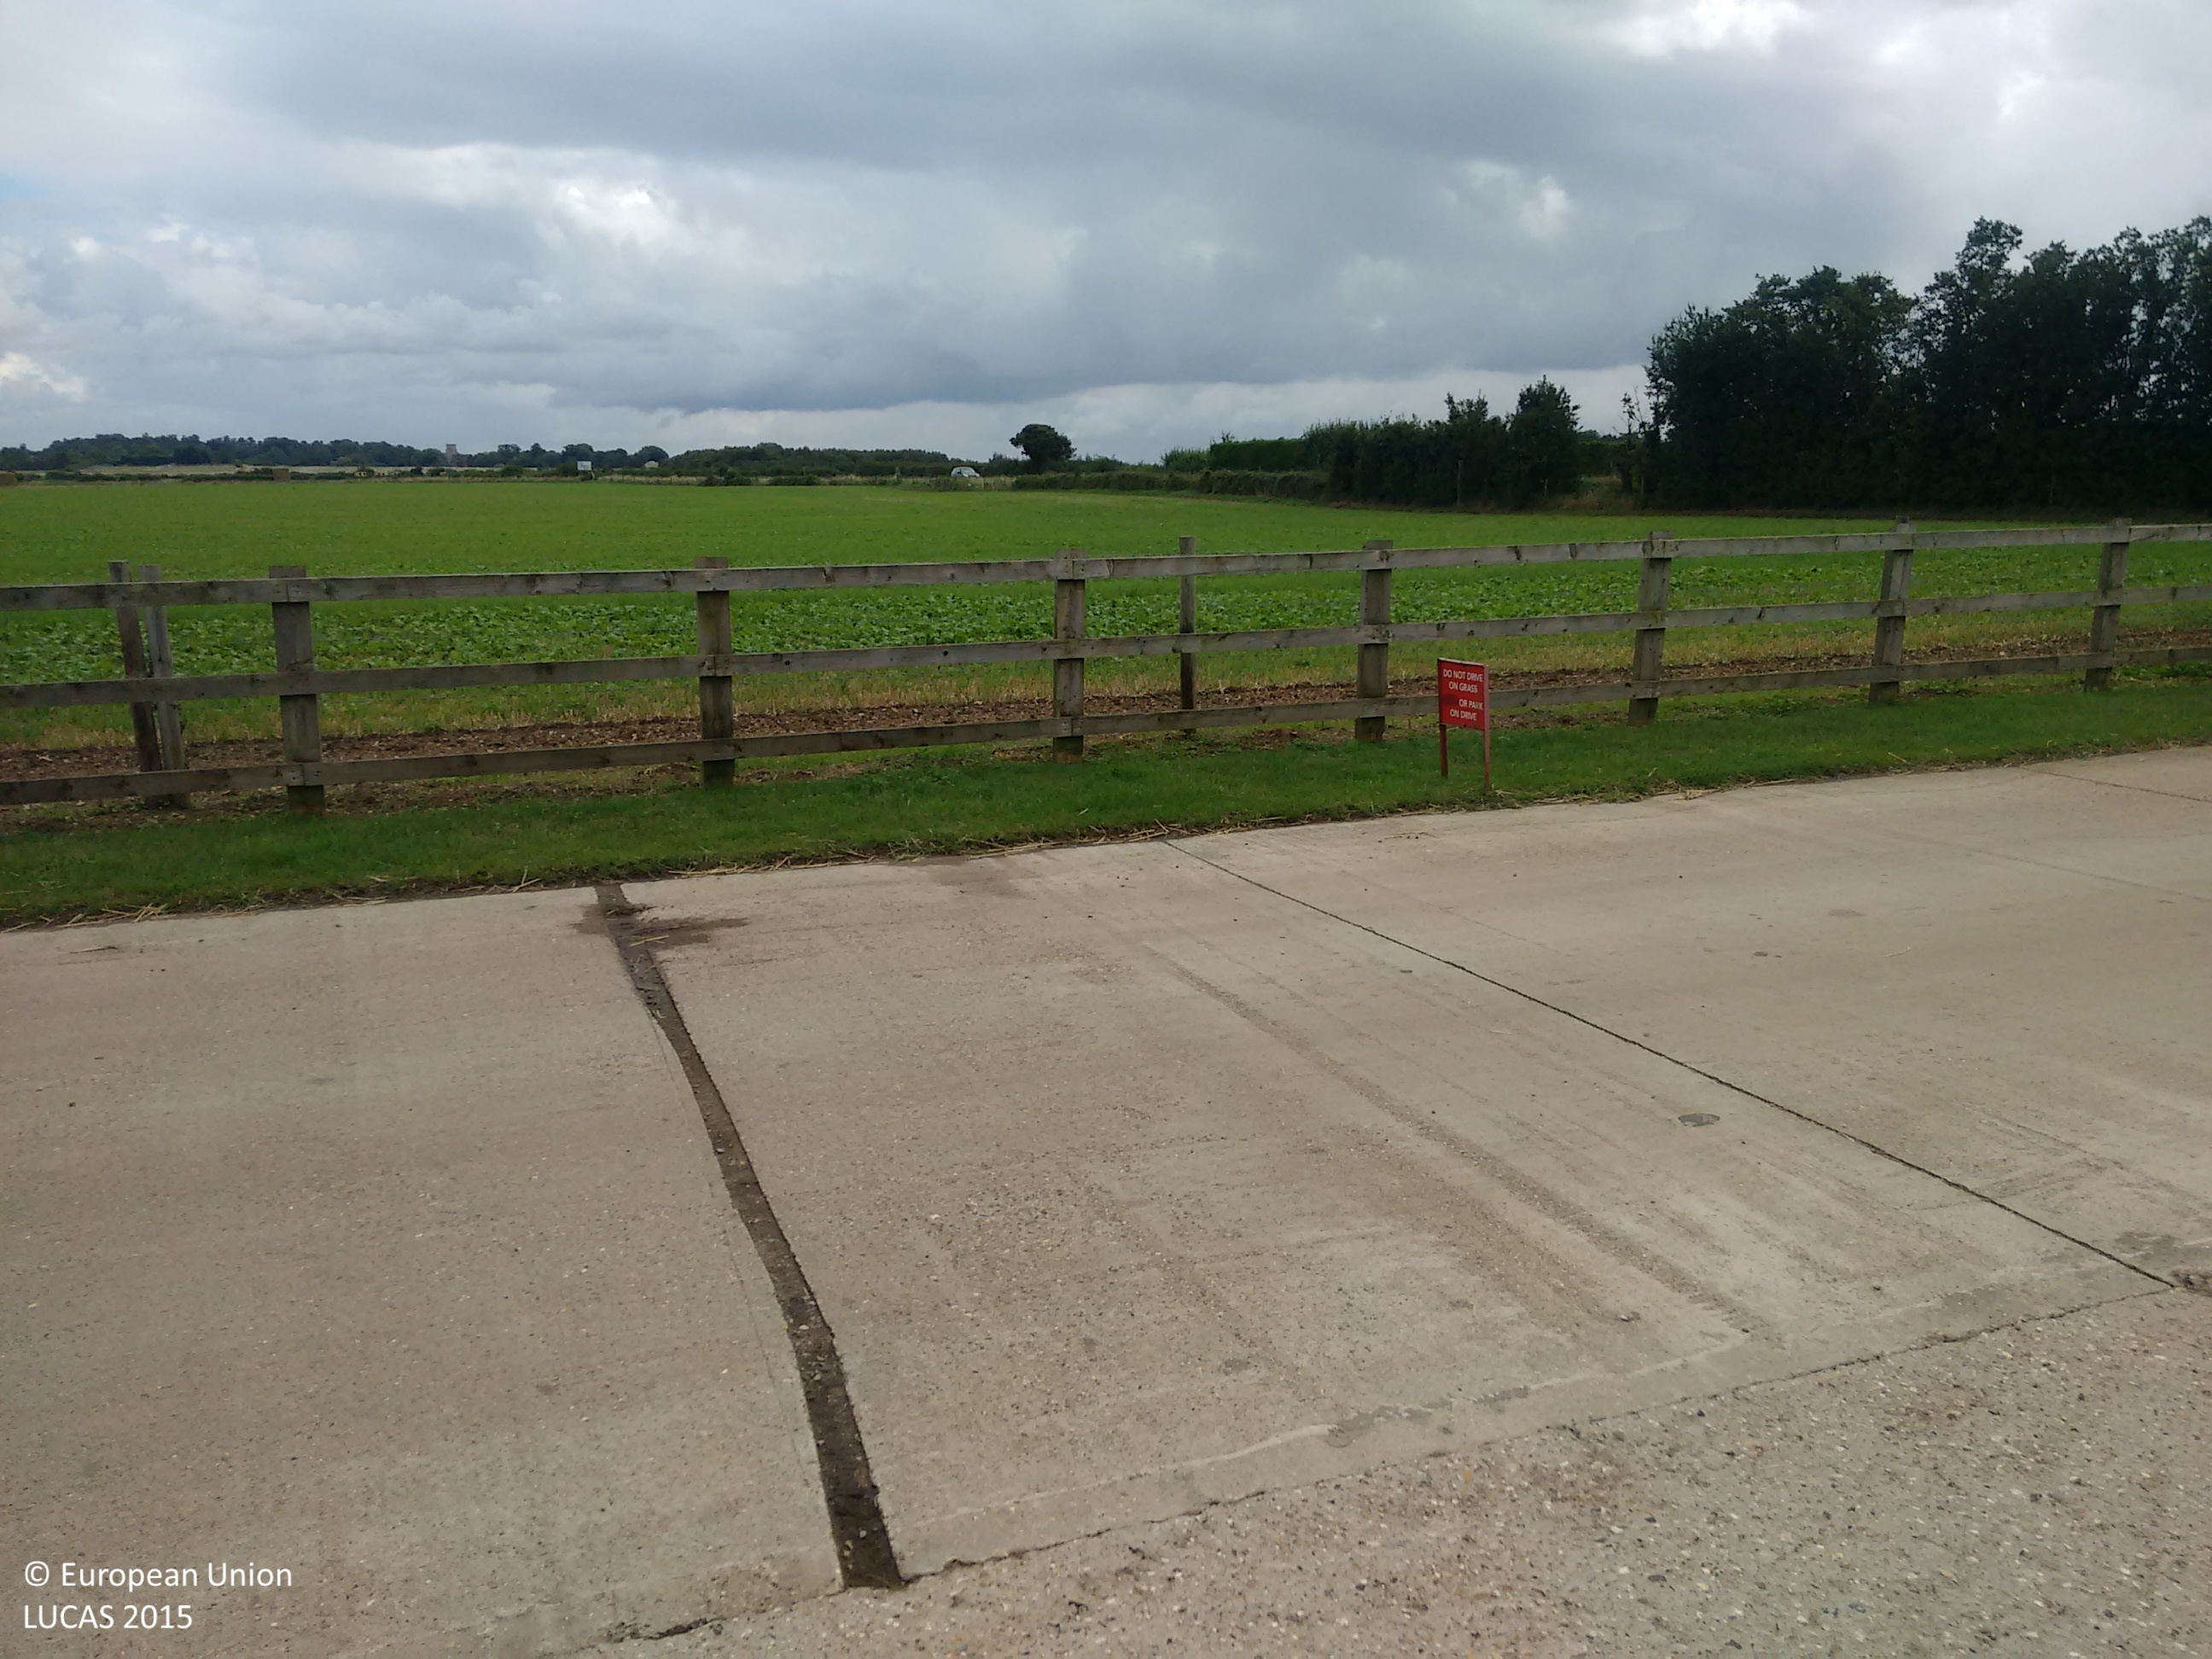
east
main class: Grassland
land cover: Grassland with sparse tree/shrub cover
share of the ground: > 75 %
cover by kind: herbaceous plants 85 %, shrubs 10 %, broadleaved forest trees 5 %
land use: Residential
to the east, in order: Grassland with sparse tree/shrub cover; Artificial constructions in urban areas; Barley; Fences; Grass margins; Paved roads, cycling and walking lanes; Grass margins; Managed hedges; Grass margins; Common wheat
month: September
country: GB
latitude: 52.3153
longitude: 0.4219
